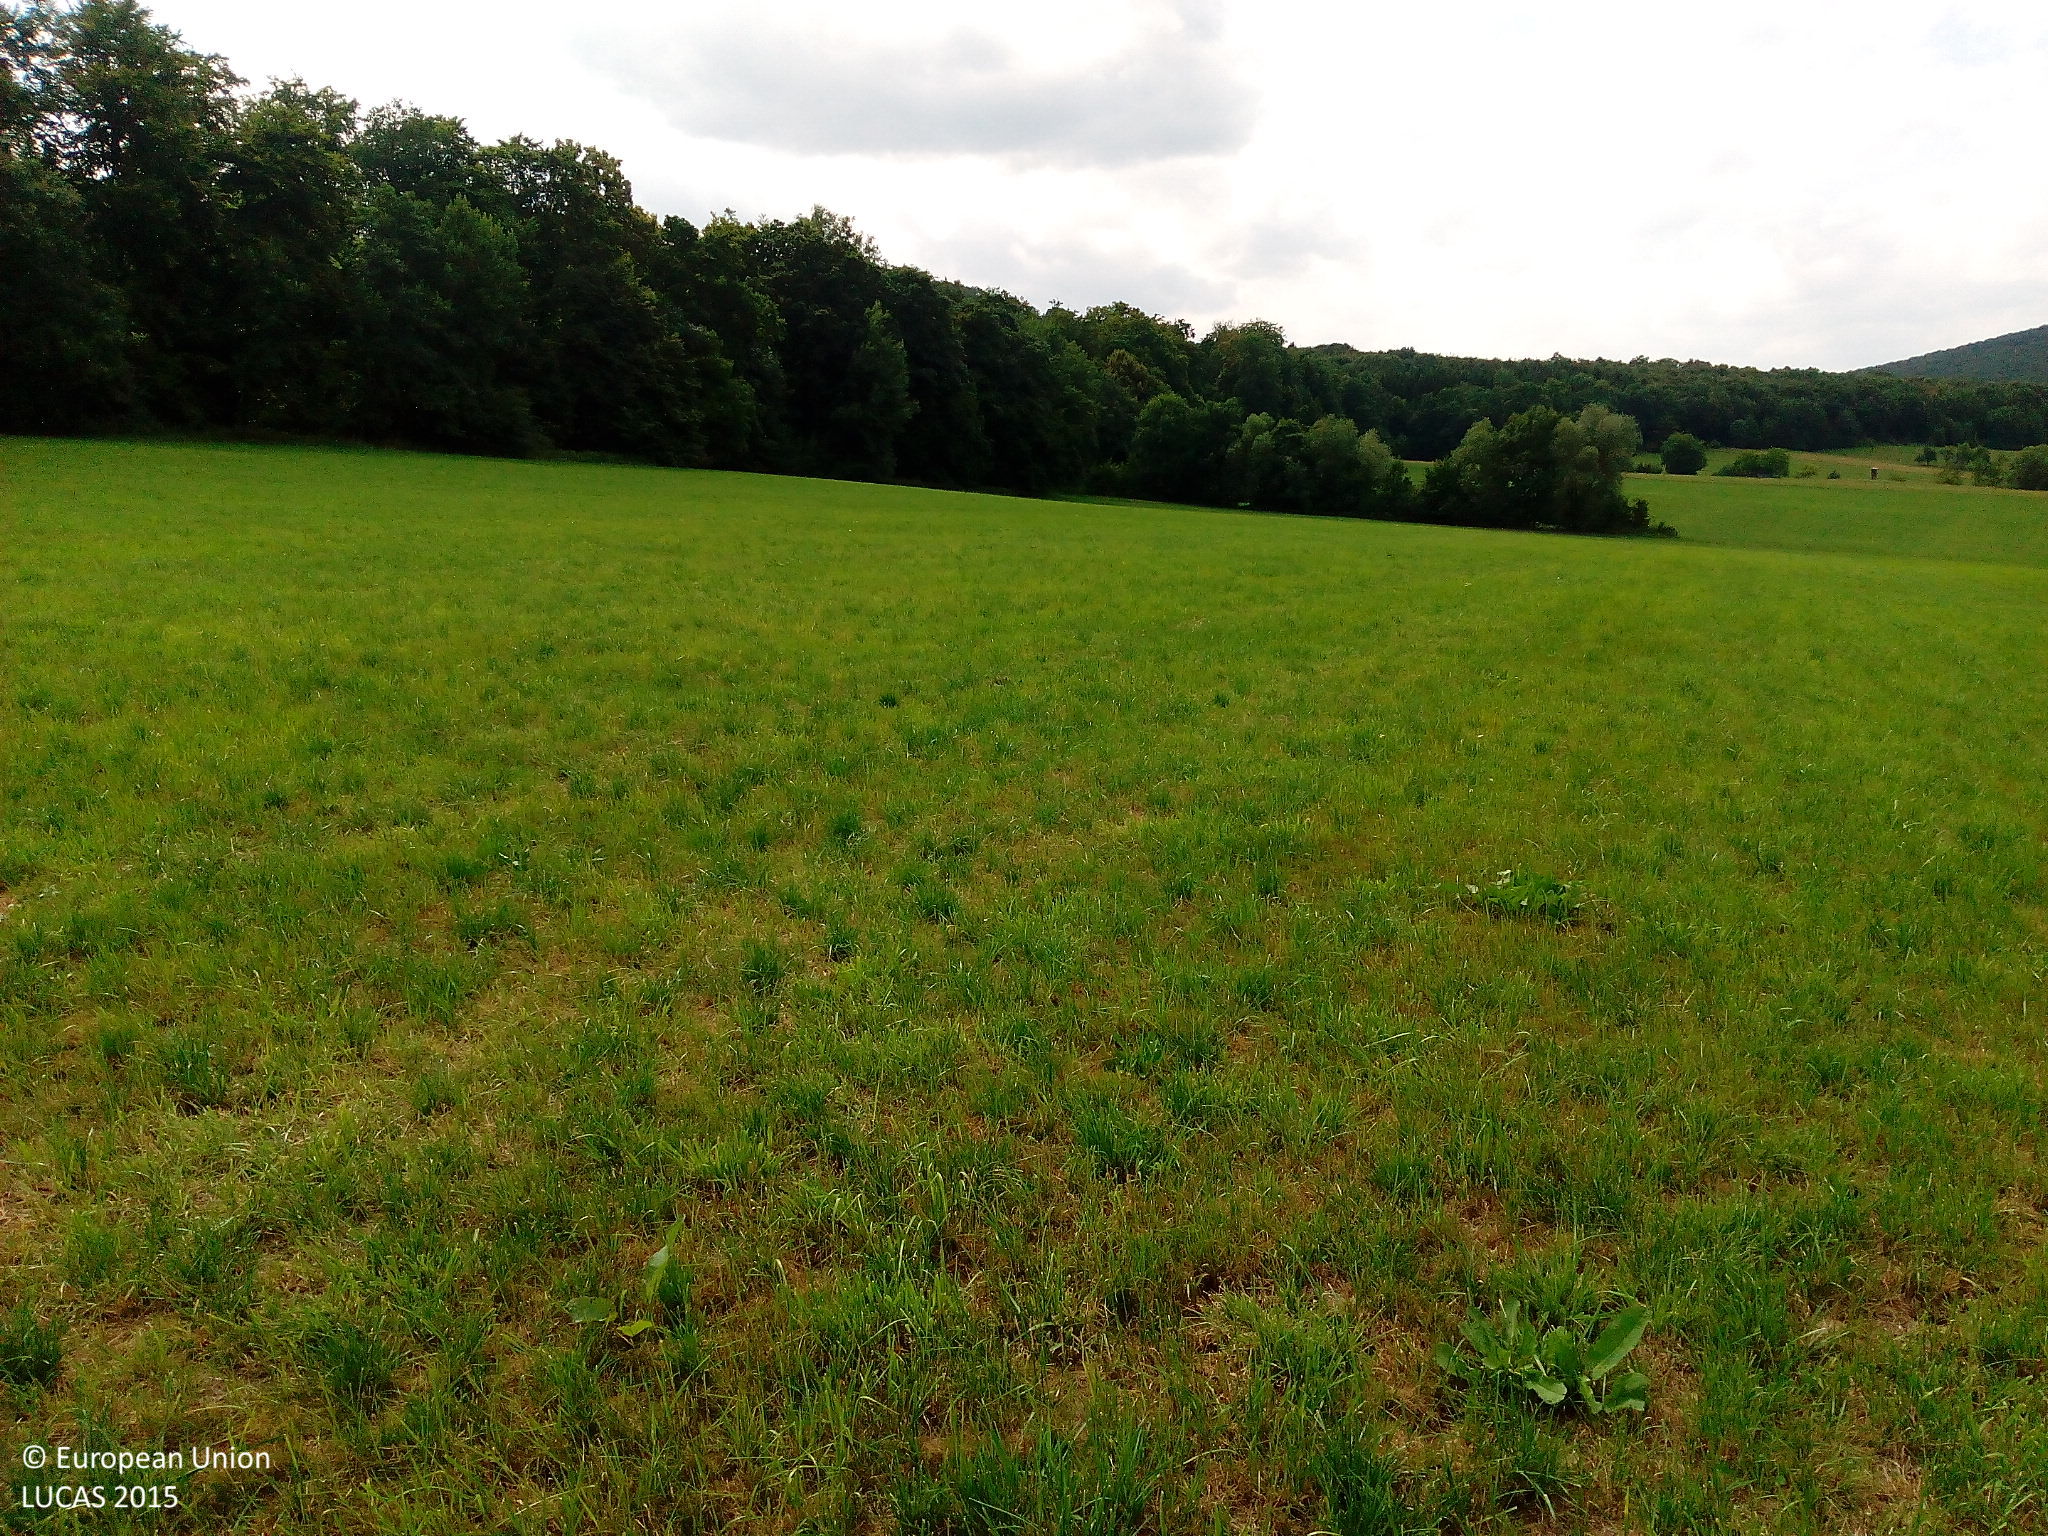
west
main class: Grassland
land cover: Grassland without tree/shrub cover
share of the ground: > 75 %
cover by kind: herbaceous plants 100 %
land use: Agriculture (excluding fallow land and kitchen gardens)
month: July
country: DE
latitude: 50.7056
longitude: 9.8726
